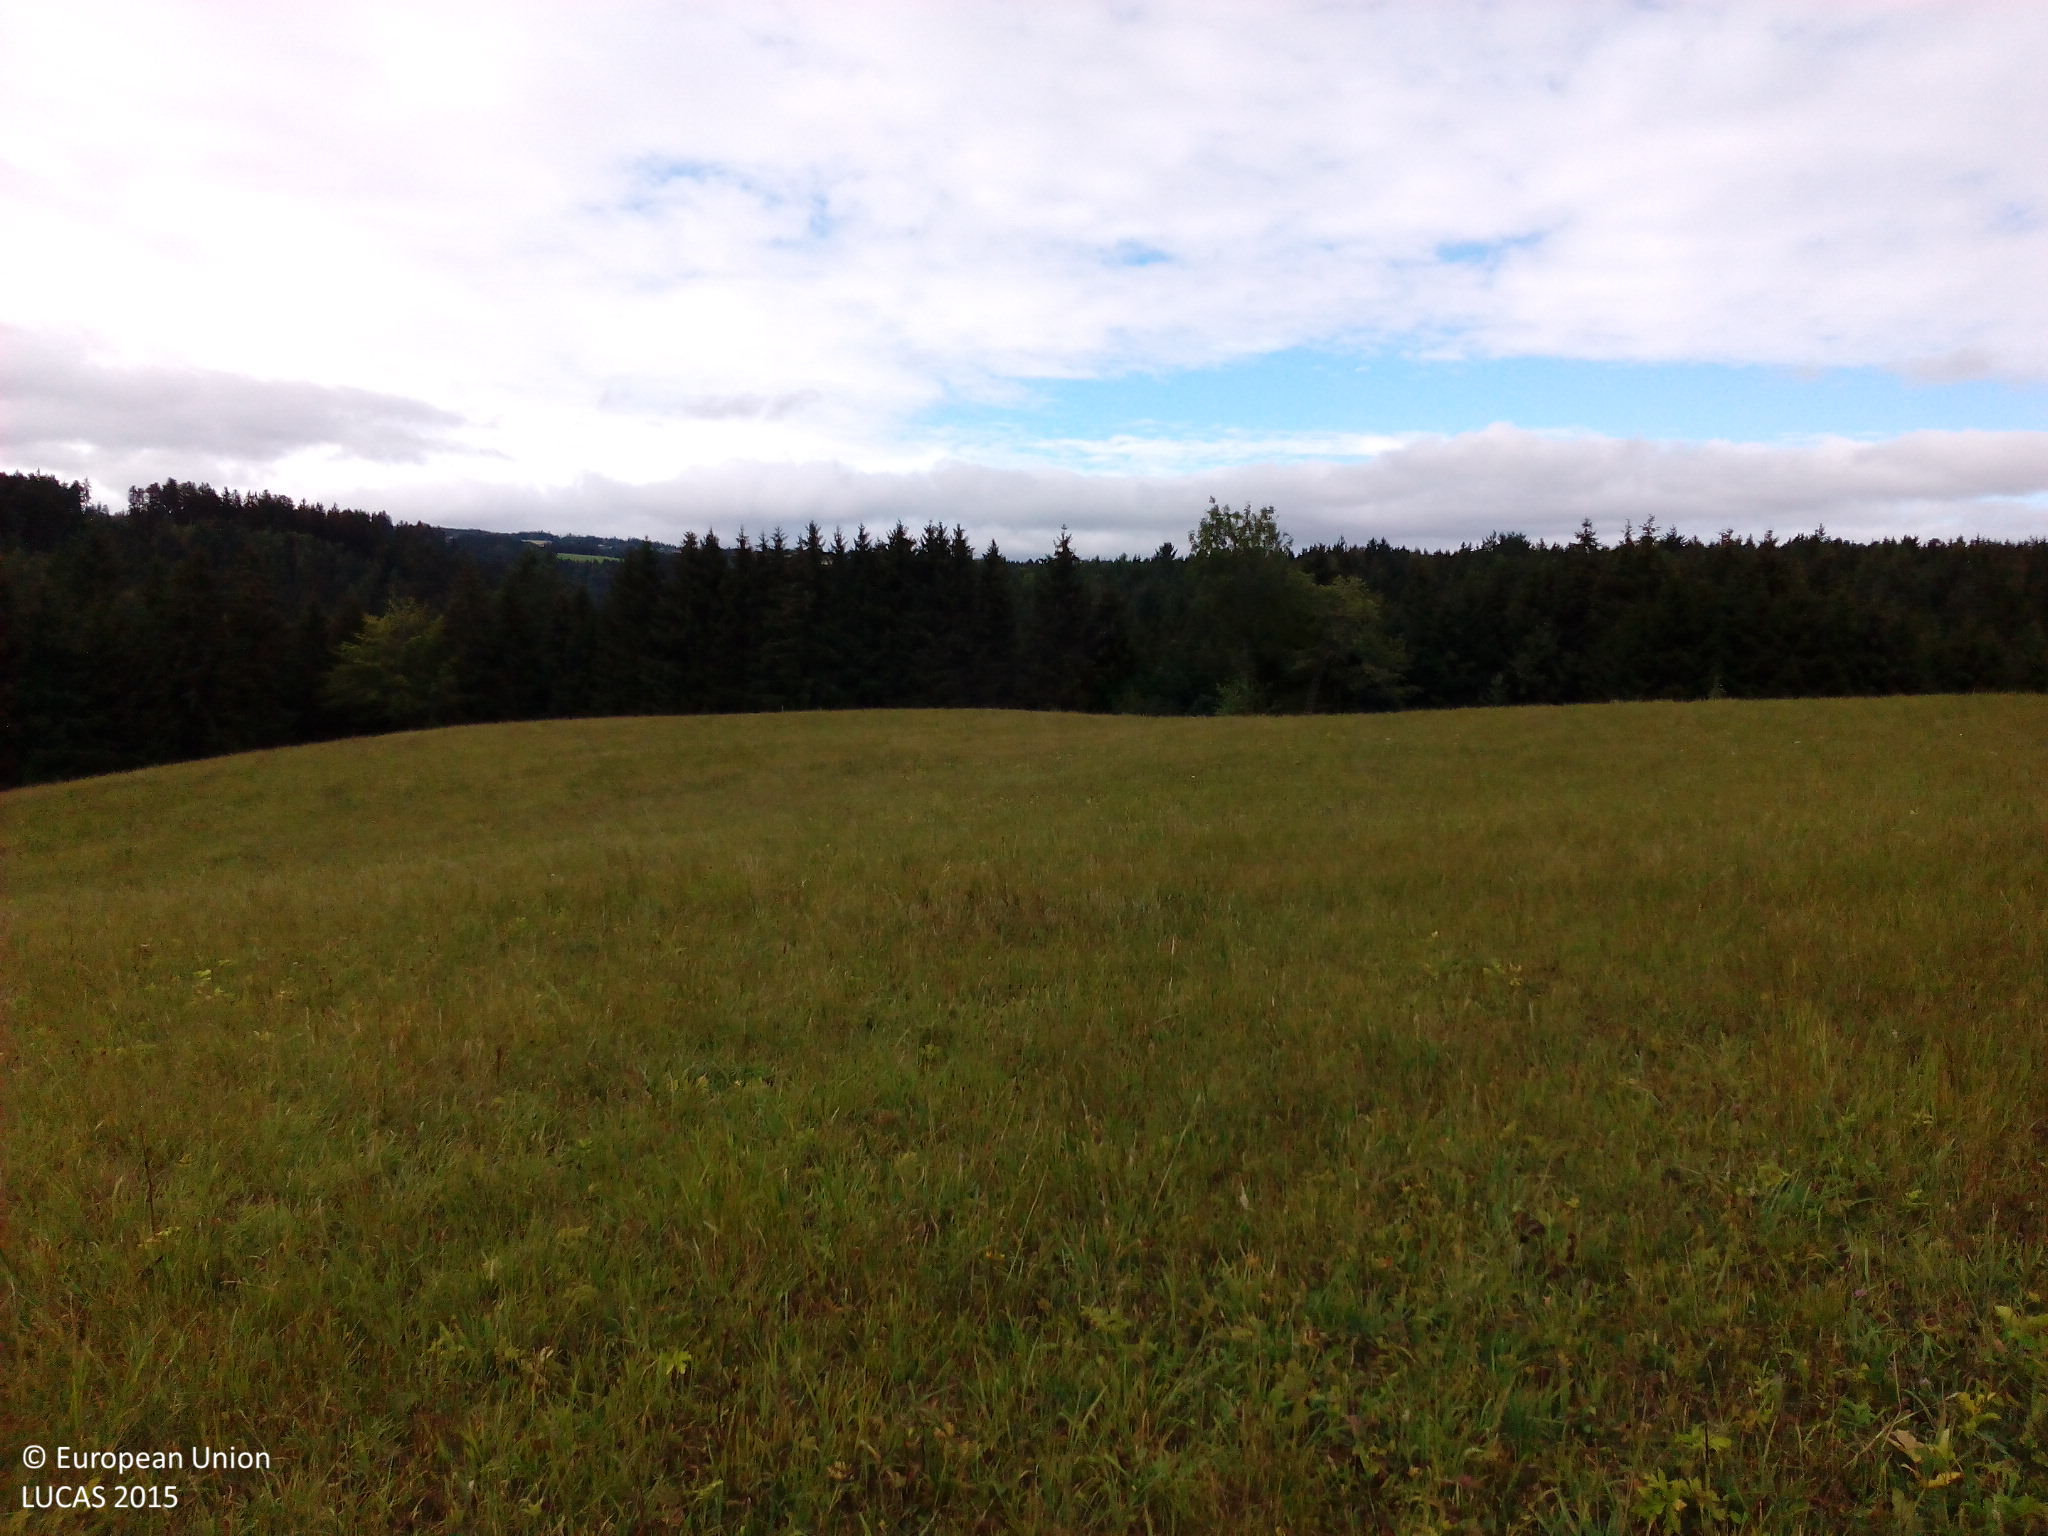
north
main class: Grassland
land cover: Grassland without tree/shrub cover
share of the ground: > 75 %
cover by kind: herbaceous plants 100 %
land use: Agriculture (excluding fallow land and kitchen gardens)
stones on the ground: < 10 %
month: August
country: DE
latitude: 47.6869
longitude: 8.2027
